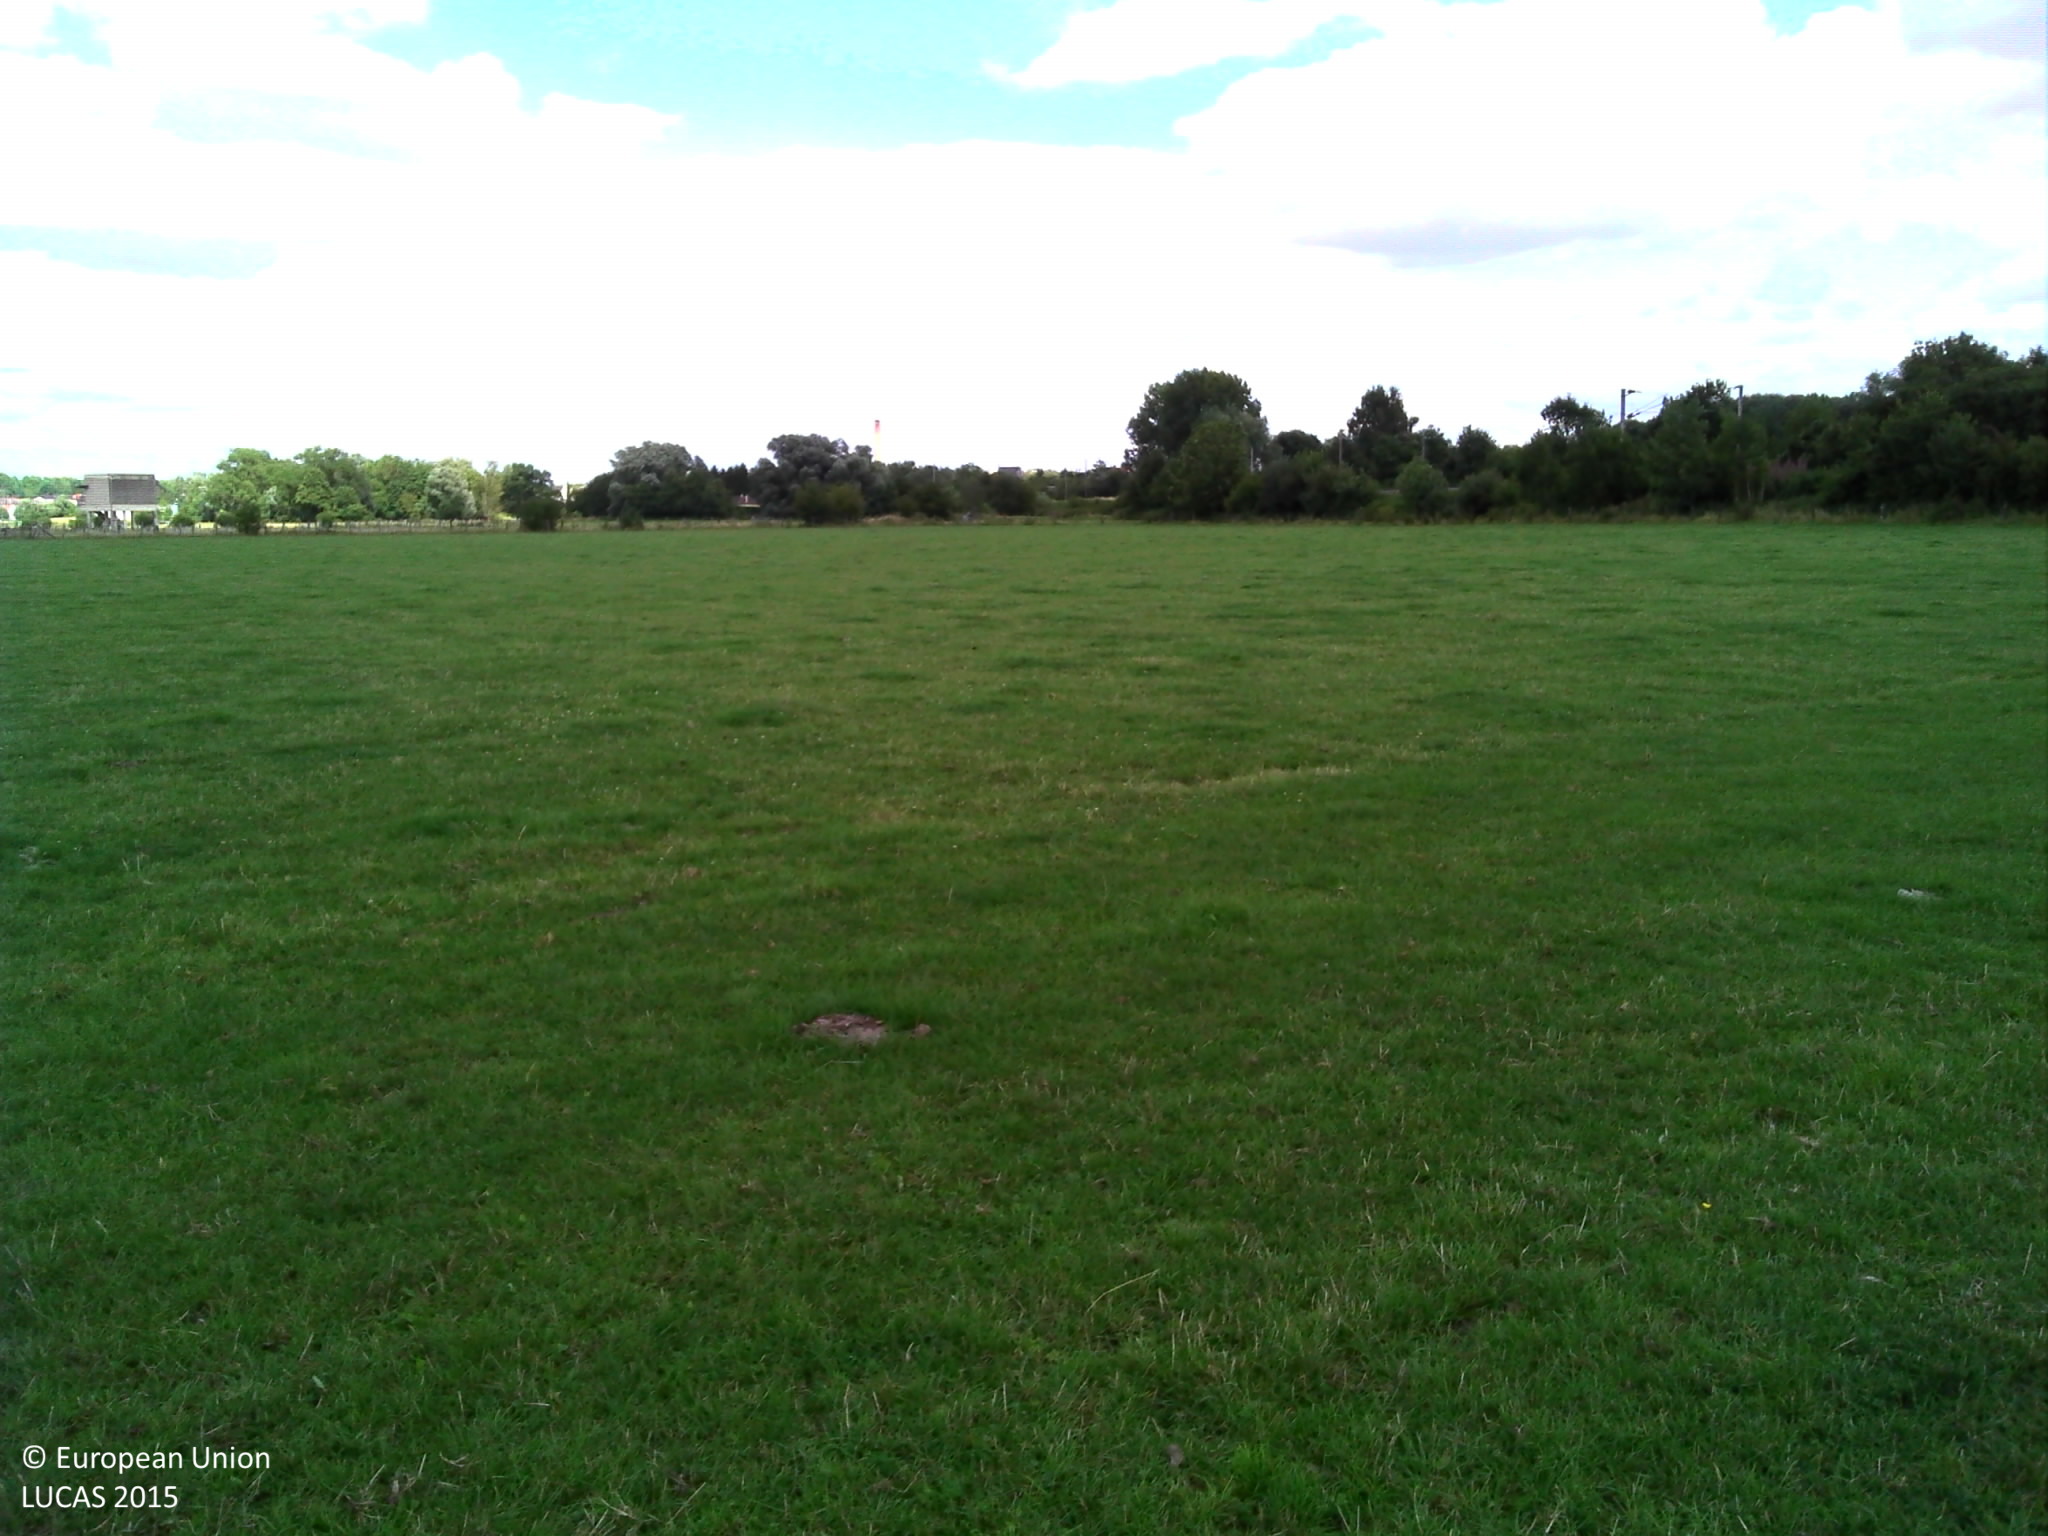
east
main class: Grassland
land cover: Grassland without tree/shrub cover
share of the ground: > 75 %
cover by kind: herbaceous plants 100 %
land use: Agriculture (excluding fallow land and kitchen gardens)
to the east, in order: Grassland without tree/shrub cover; Fences; Grass margins; Tracks; Abandoned hedges
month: August
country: FR
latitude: 50.2788
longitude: 4.0023
